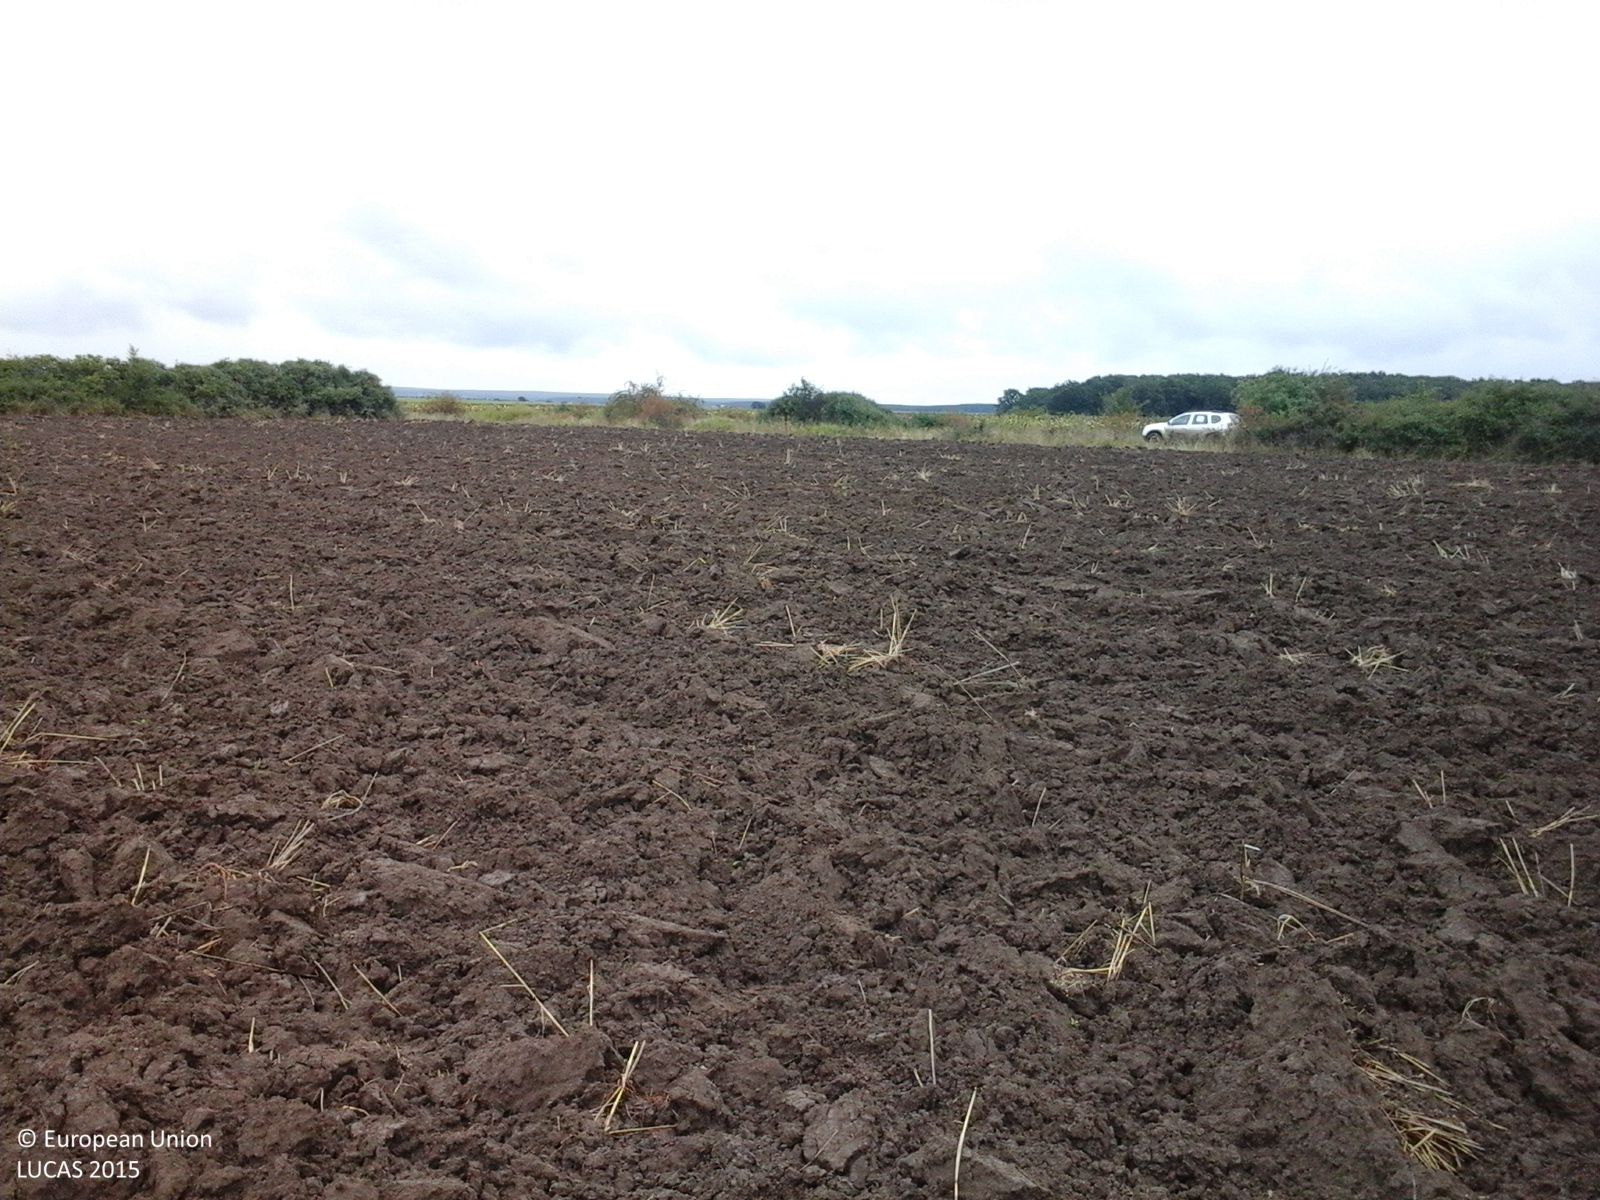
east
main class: Cropland
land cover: Common wheat
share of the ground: < 10 %
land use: Agriculture (excluding fallow land and kitchen gardens)
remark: Harvested field
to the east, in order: Common wheat; Shruby margins; Ditches and canals; Shruby margins; Tracks; Abandoned hedges; Tracks; Abandoned hedges; Sunflower; Ditches and canals; Sunflower
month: September
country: RO
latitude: 46.8559
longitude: 21.8353
